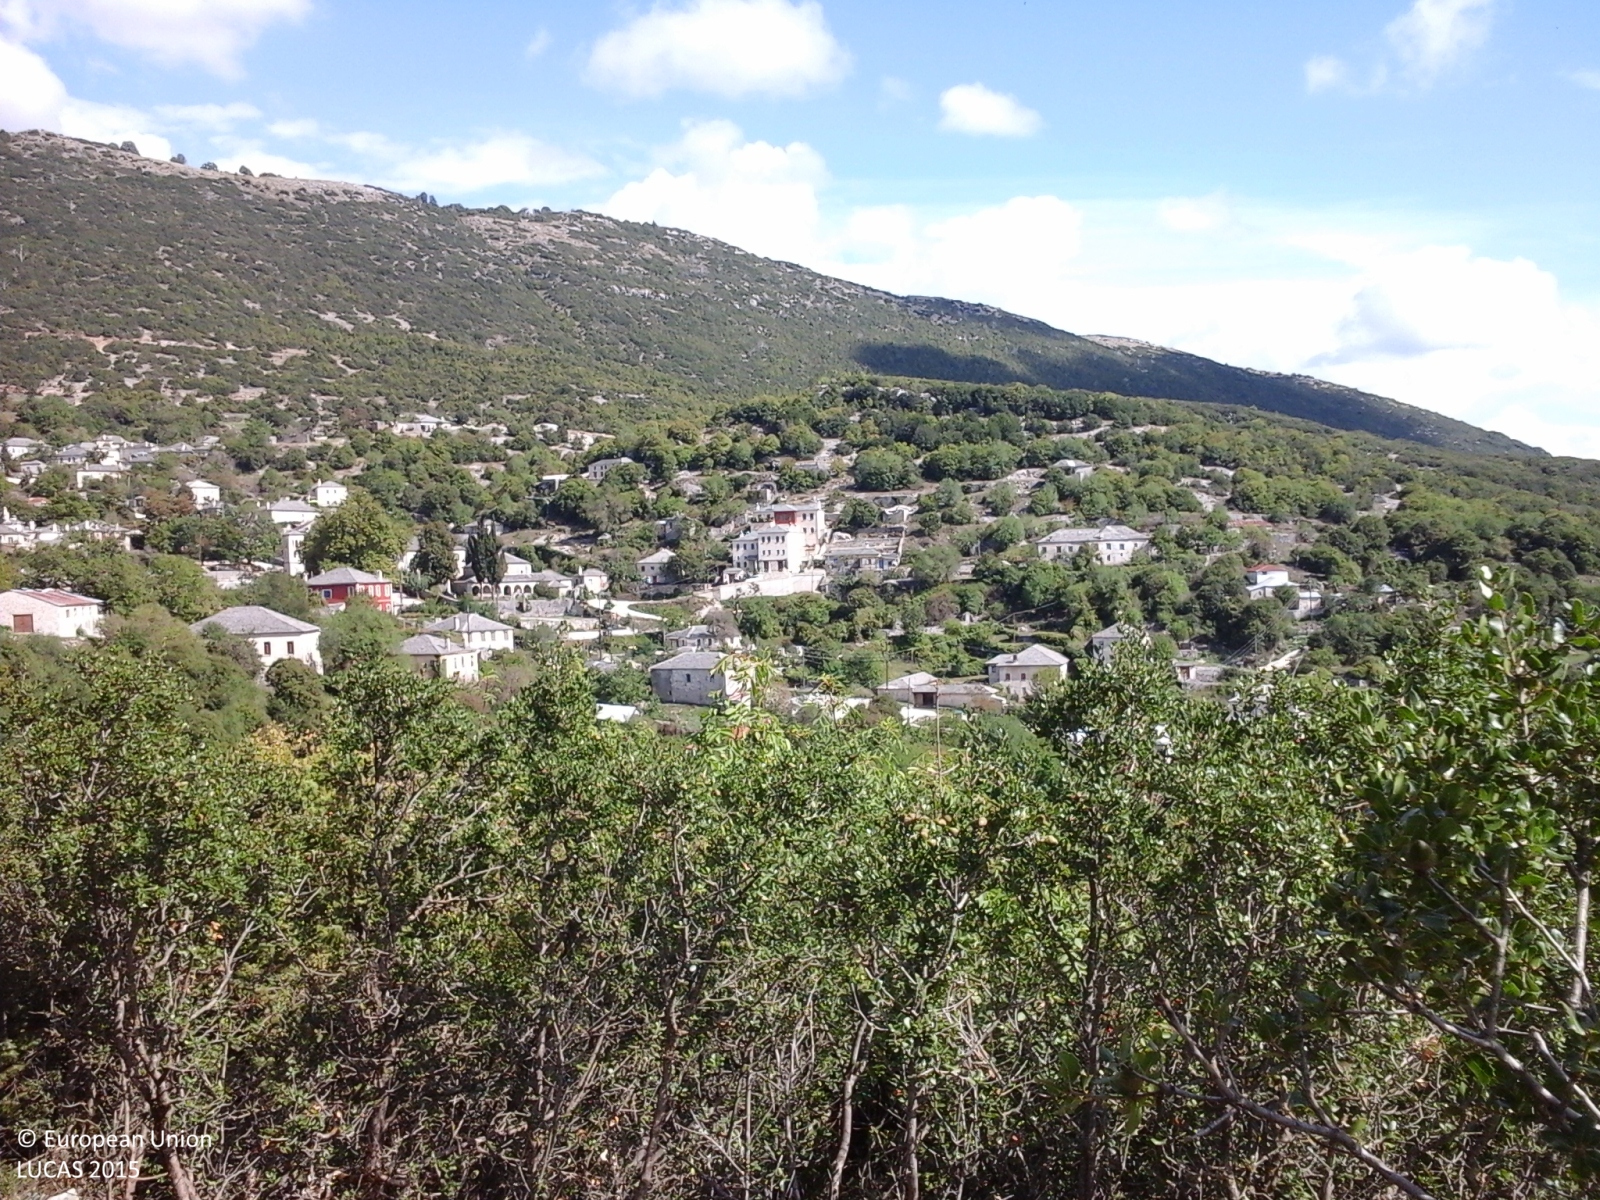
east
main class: Shrubland
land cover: Shrubland with sparse tree cover
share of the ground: > 75 %
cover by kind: shrubs 90 %, broadleaved forest trees 5 %, herbaceous plants 5 %
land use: Semi-natural and natural areas not in use
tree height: < 5 m
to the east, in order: Shrubland with sparse tree cover; Spontaneously vegetated surfaces; Fences; Abandoned hedges; Spontaneously vegetated surfaces; Fences; Broadleaved woodland; Tracks; Broadleaved woodland; Artificial constructions in urban areas; Broadleaved woodland
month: September
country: GR
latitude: 39.8808
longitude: 20.7023
